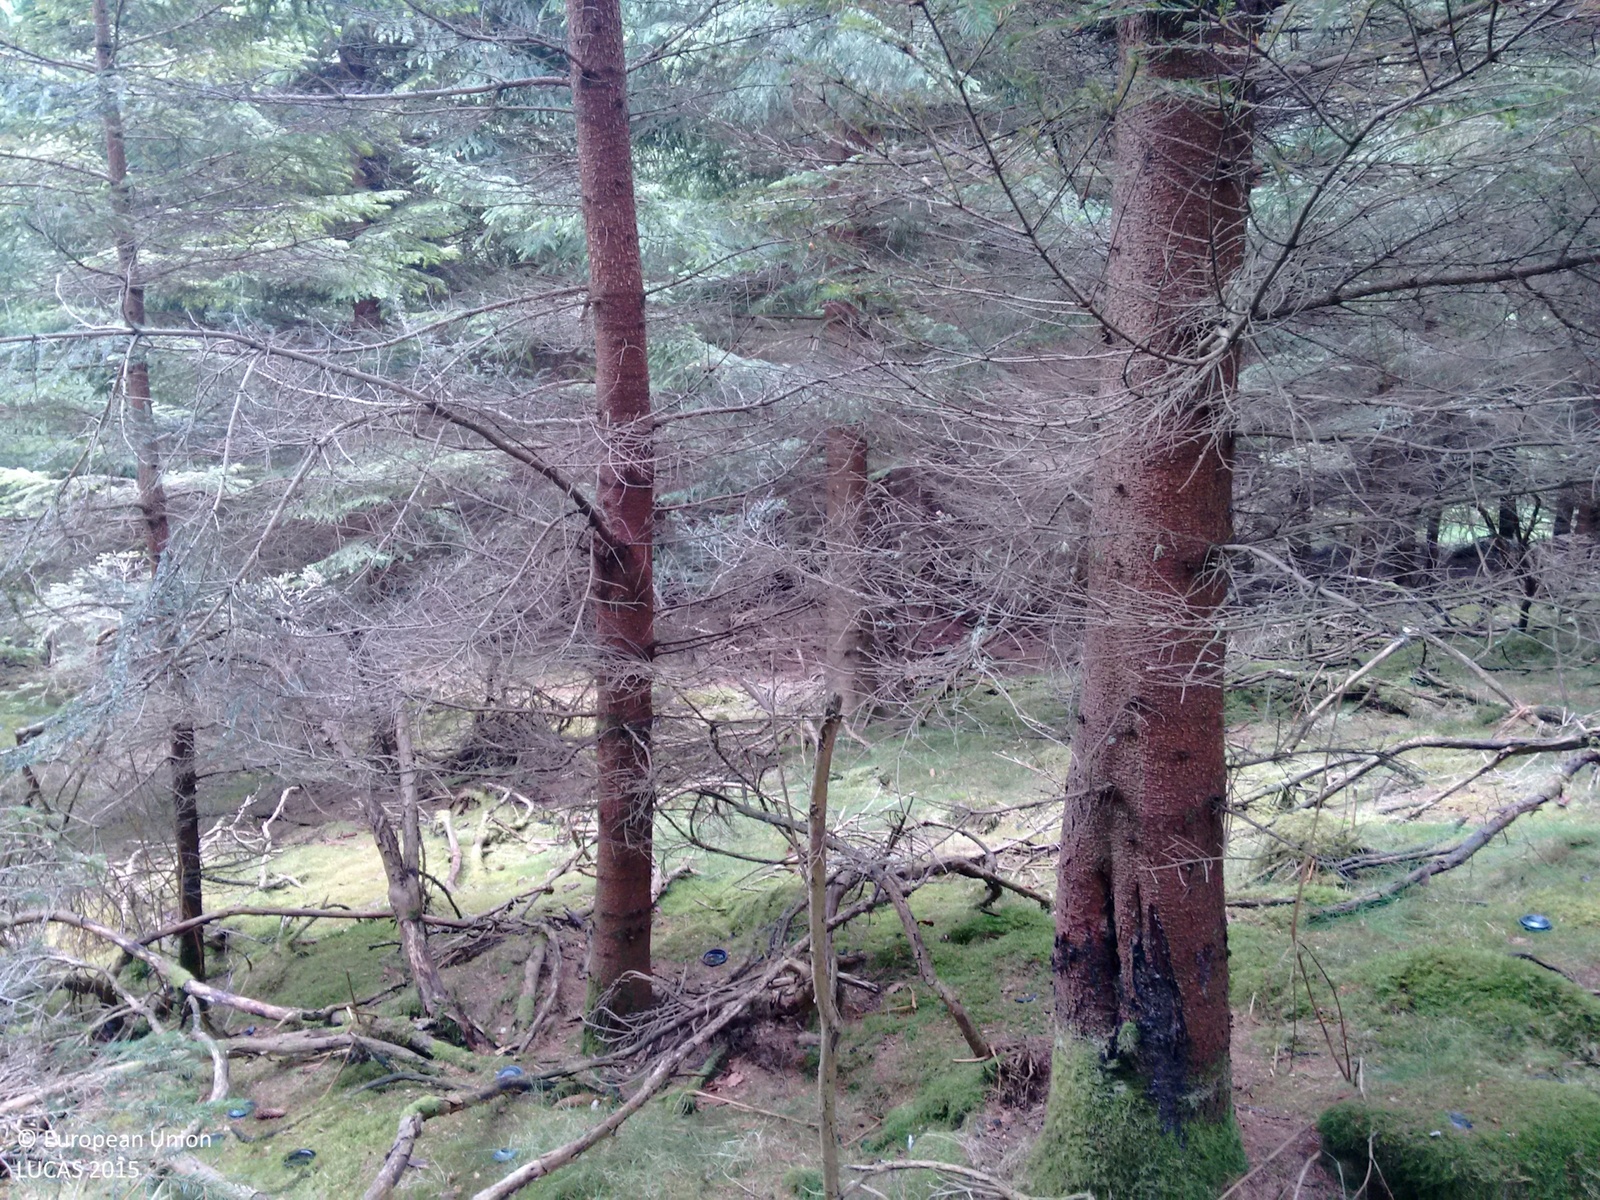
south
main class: Woodland
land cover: Spruce dominated coniferous woodland
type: exotic forest
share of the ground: > 75 %
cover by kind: coniferous forest trees 95 %, lichens and mosses 5 %
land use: Forestry
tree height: > 5 m
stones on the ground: < 10 %
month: June
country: GB
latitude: 57.0981
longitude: -2.7521
